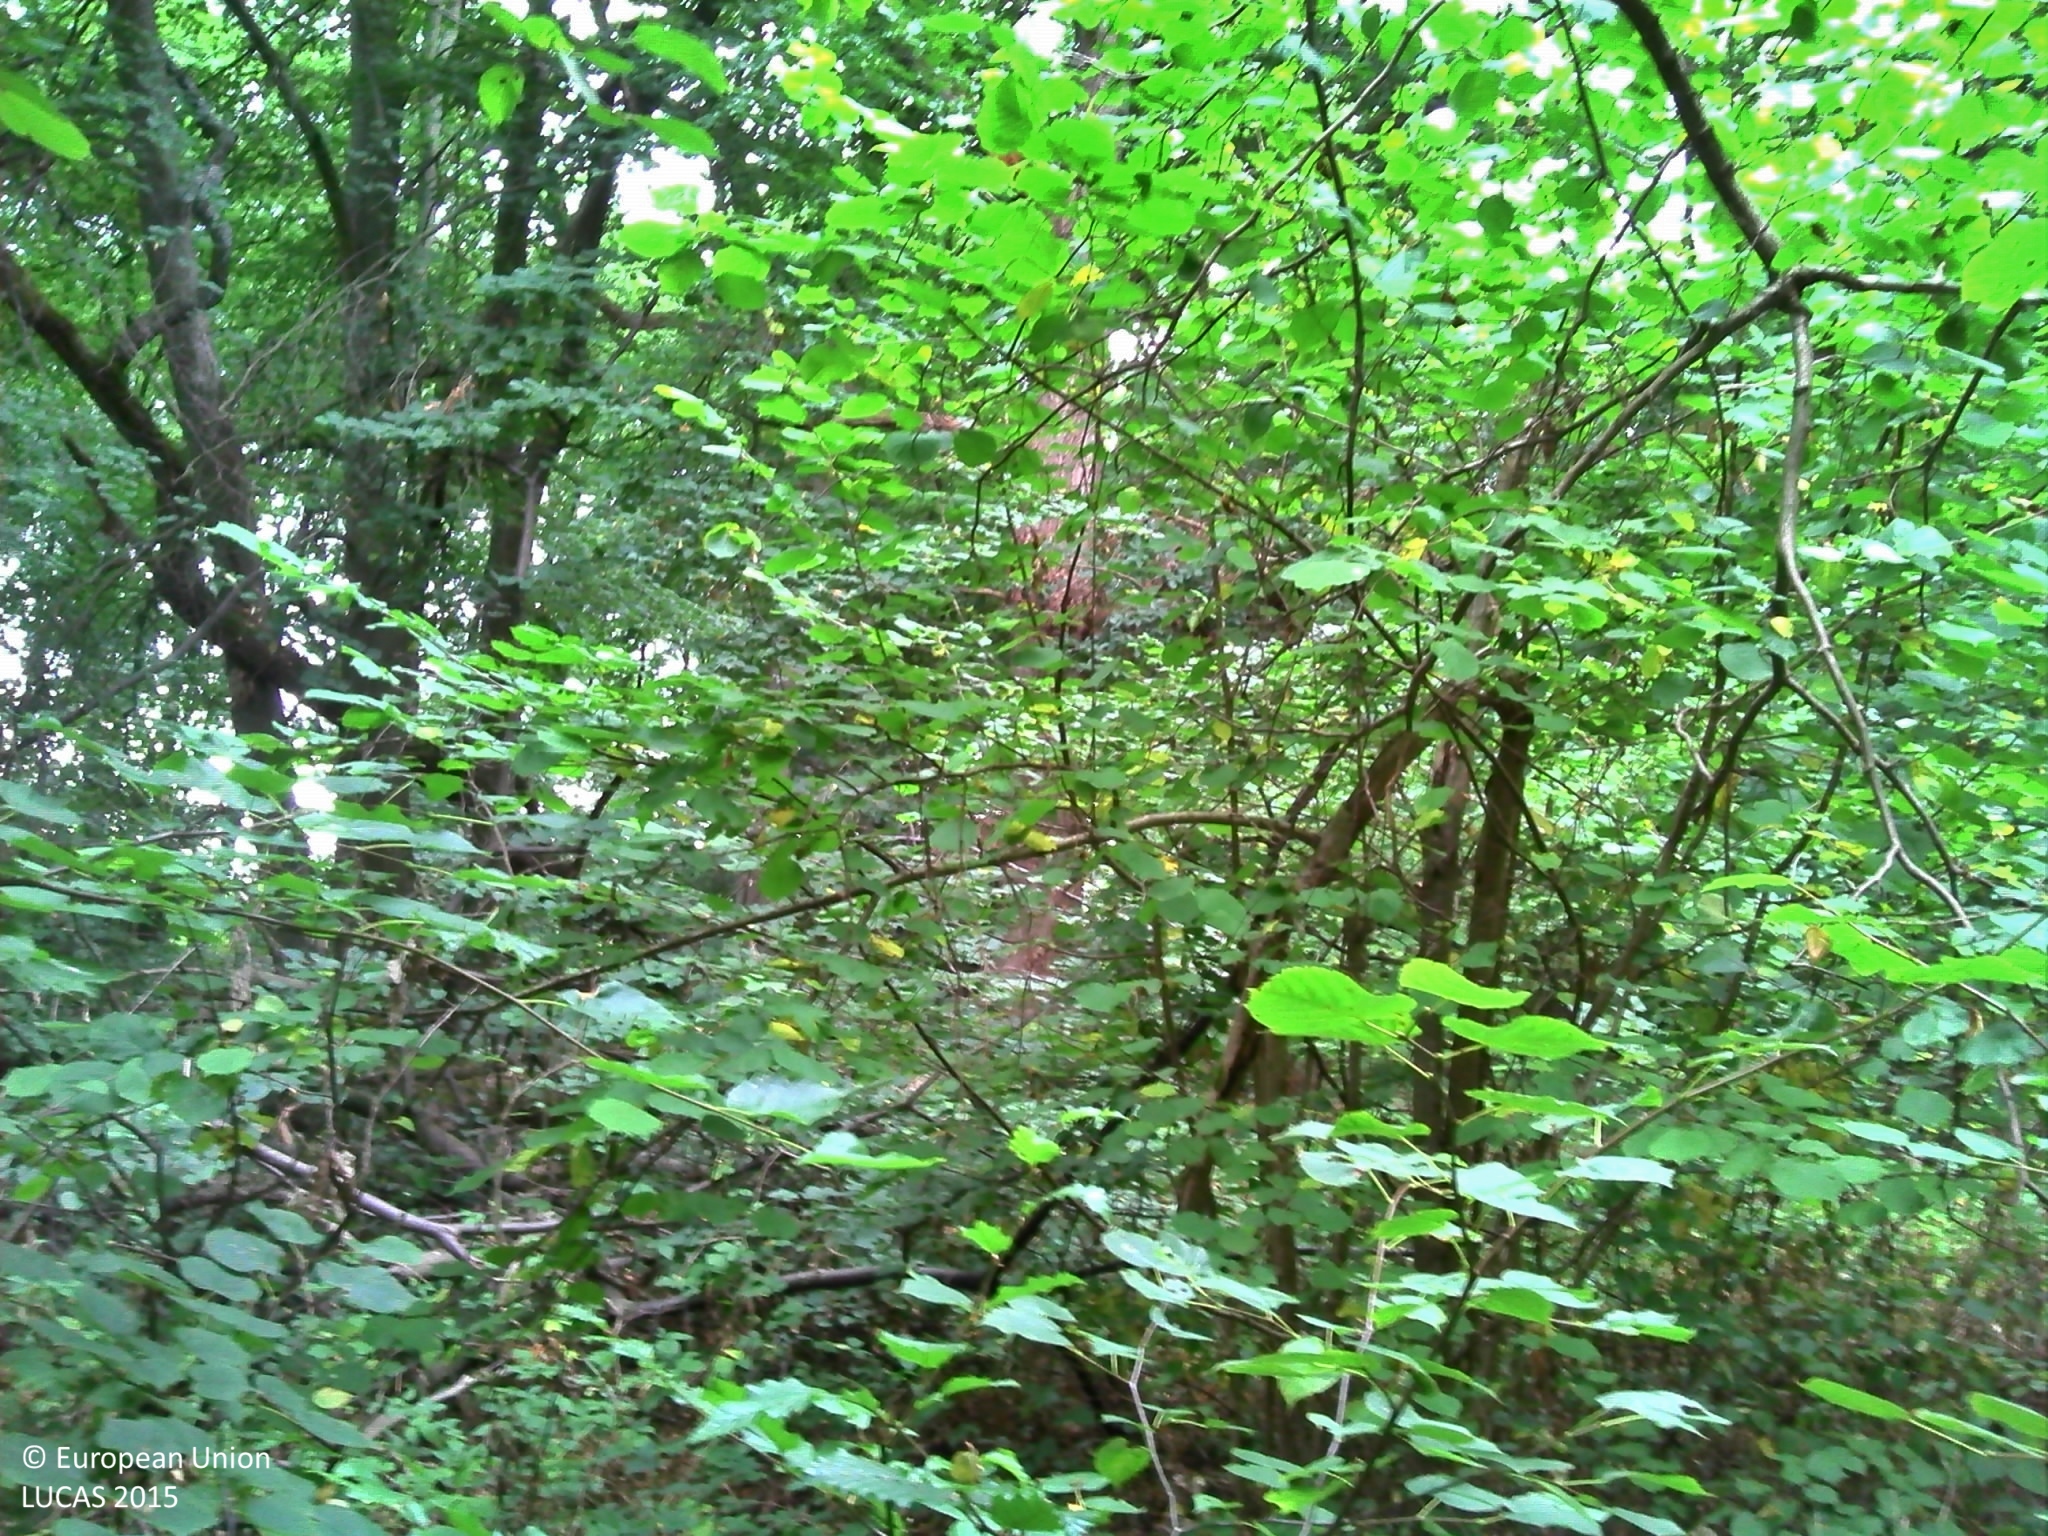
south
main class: Woodland
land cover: Broadleaved woodland
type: acidophilous oak and oak-birch forest
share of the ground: > 75 %
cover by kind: broadleaved forest trees 75 %, herbaceous plants 15 %, shrubs 10 %
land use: Forestry
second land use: Amenities, museums, leisure
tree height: > 5 m
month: July
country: FR
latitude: 49.1577
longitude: 2.4601
